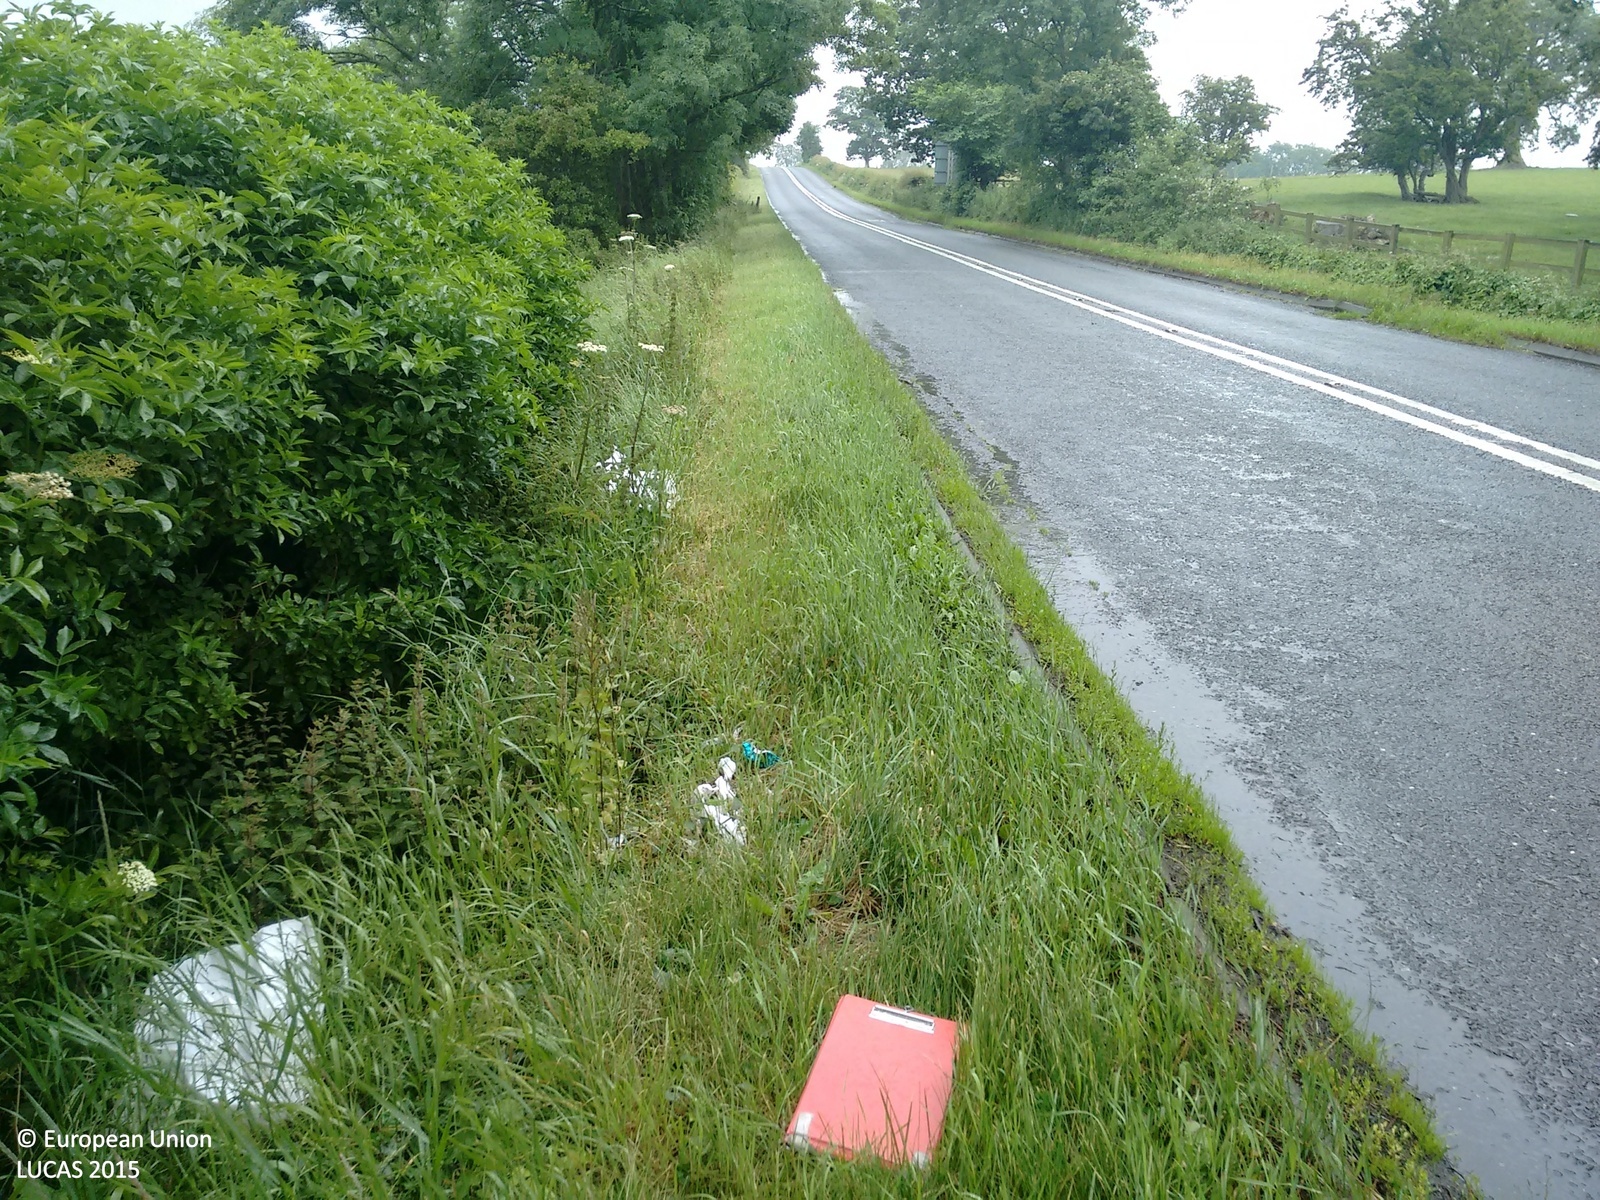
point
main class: Woodland
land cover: Broadleaved woodland
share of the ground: > 75 %
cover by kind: broadleaved forest trees 45 %, herbaceous plants 15 %
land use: Semi-natural and natural areas not in use
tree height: > 5 m
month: July
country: GB
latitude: 54.5452
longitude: -1.8482
